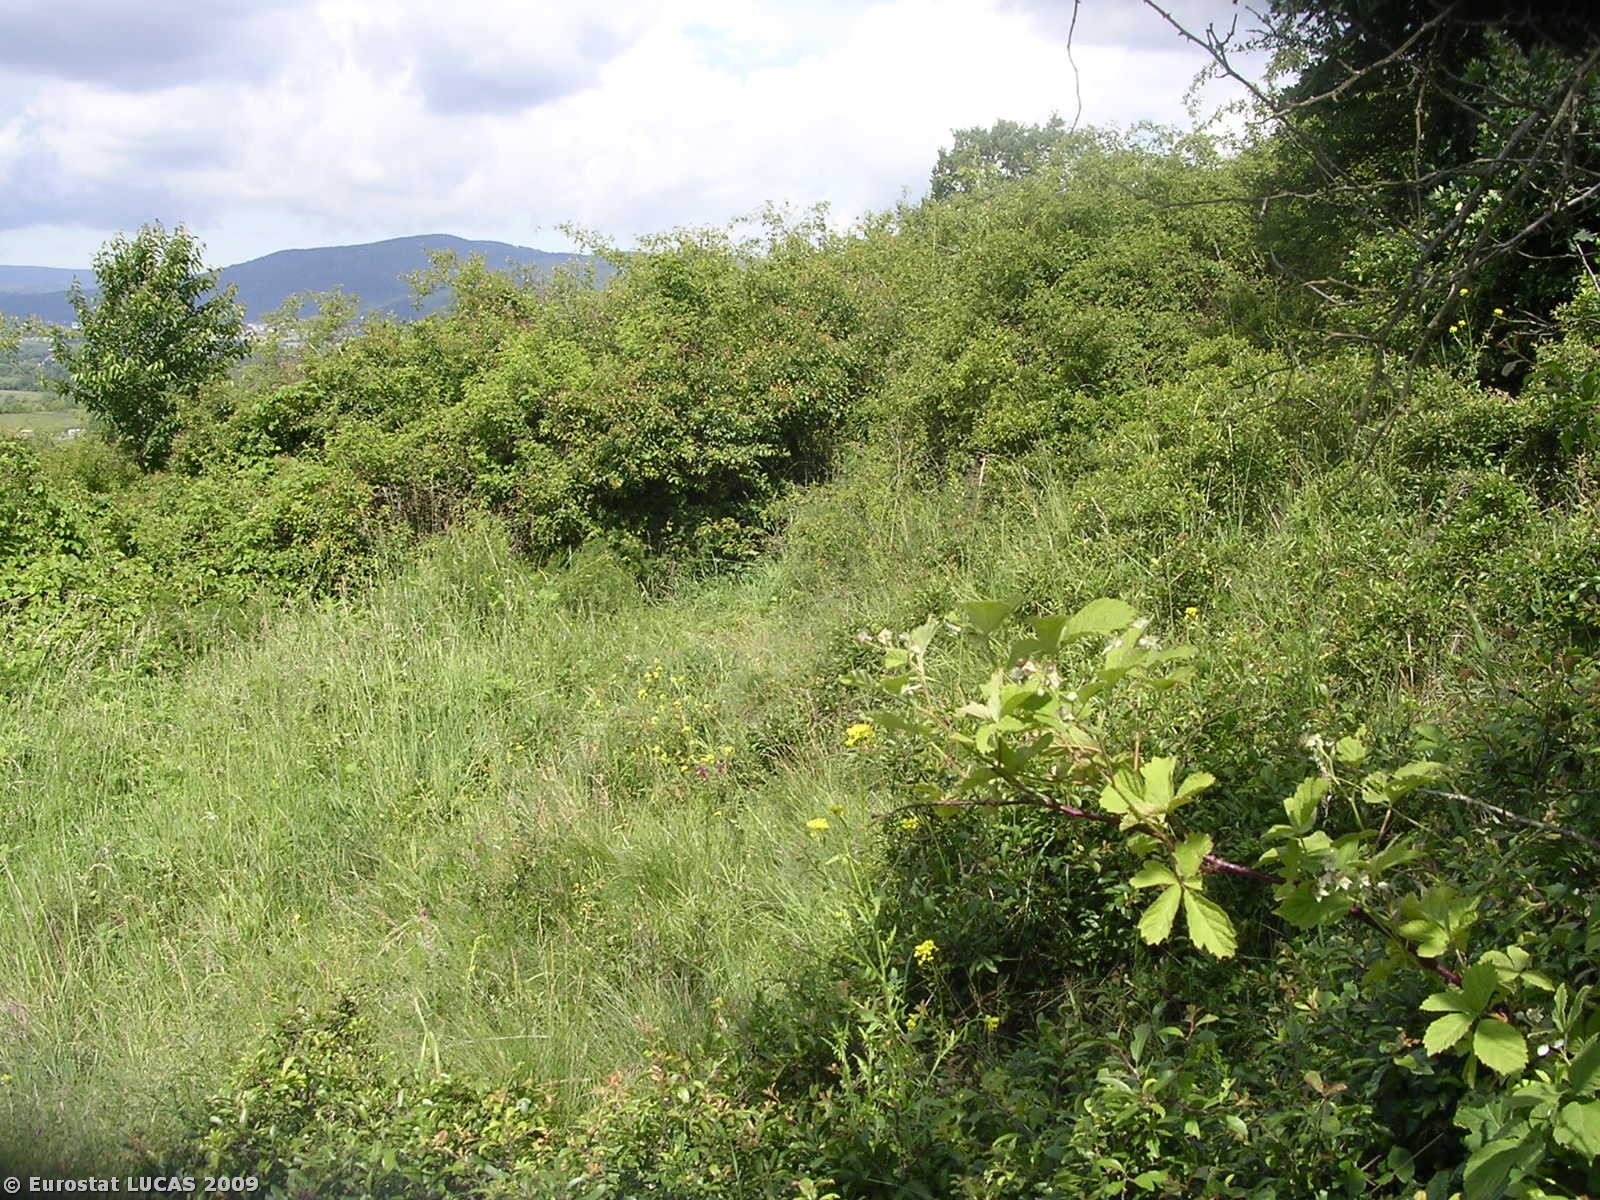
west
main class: Shrubland
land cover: Shrubland with sparse tree cover
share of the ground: 50 - 75 %
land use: Unused
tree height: > 5 m
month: June
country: CZ
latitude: 50.6730
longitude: 13.9772
